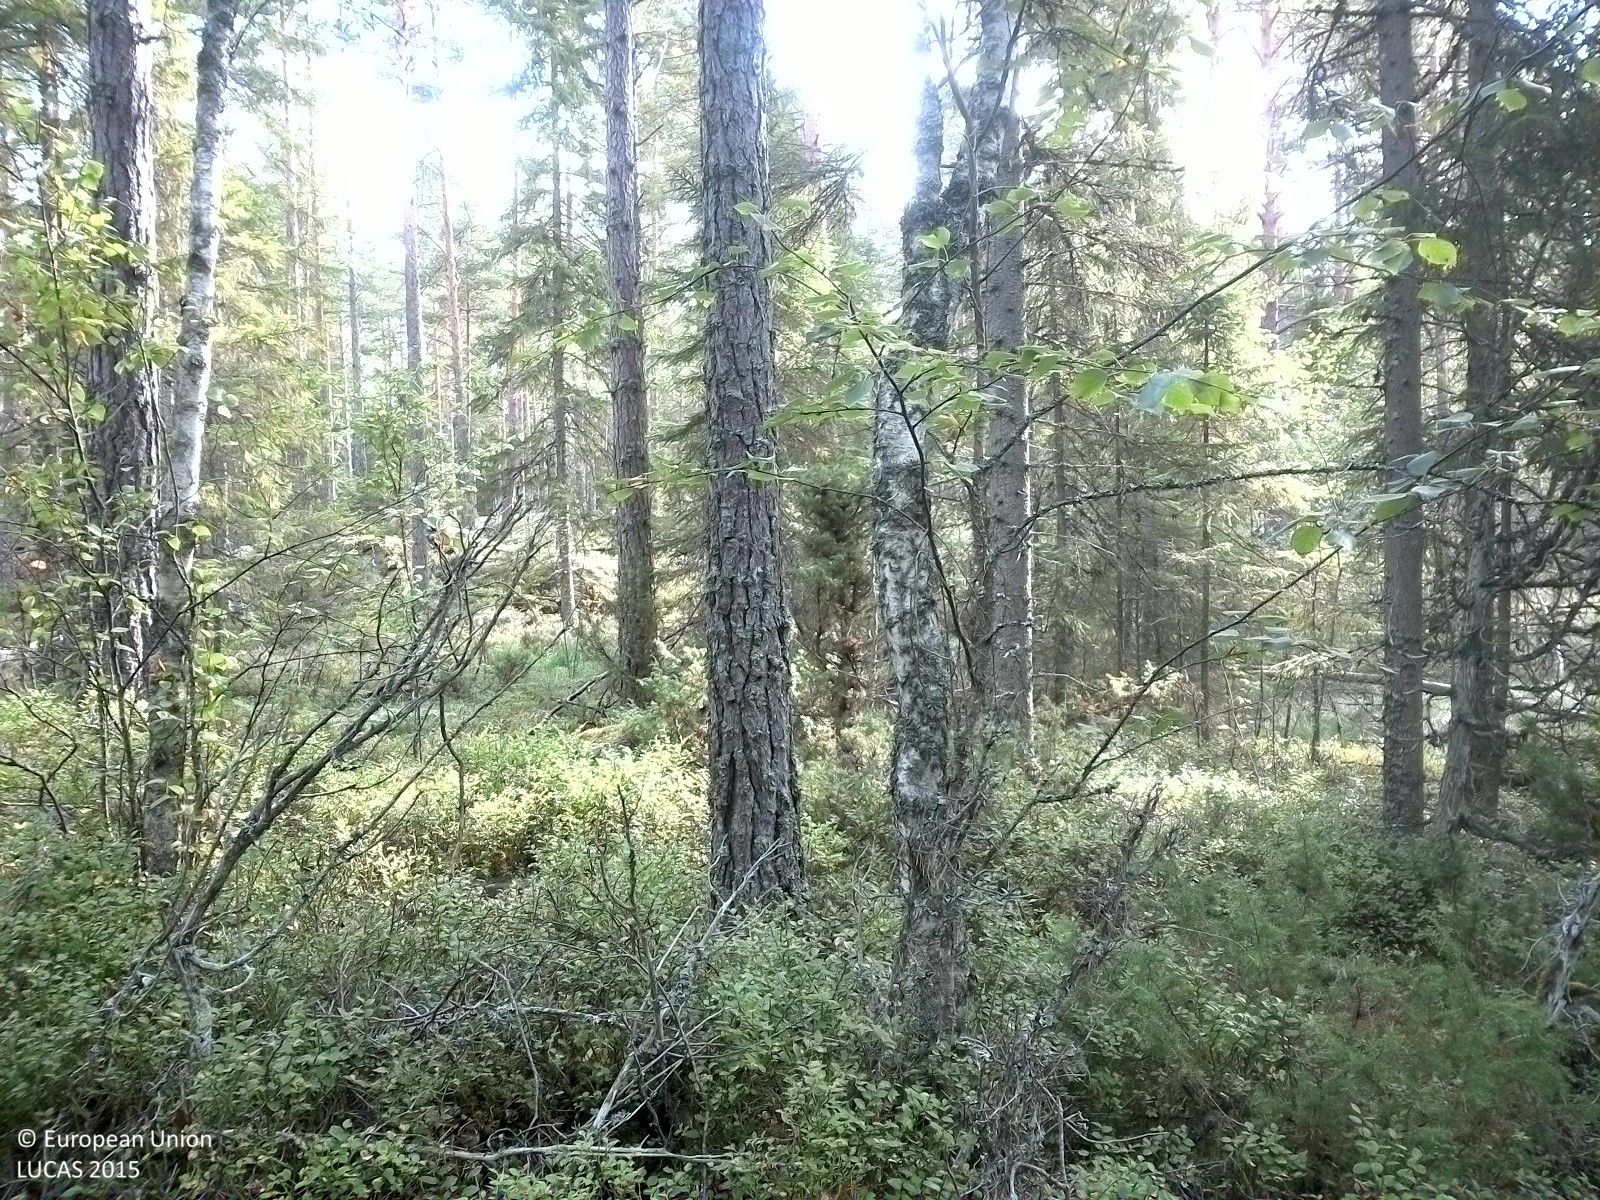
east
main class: Woodland
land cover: Pine dominated coniferous woodland
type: boreal forest
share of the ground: 25 - 50 %
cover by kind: coniferous forest trees 35 %, herbaceous plants 35 %, lichens and mosses 20 %, broadleaved forest trees 5 %, shrubs 5 %
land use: Forestry
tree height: > 5 m
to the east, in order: Pine dominated coniferous woodland; Spruce dominated coniferous woodland
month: August
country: SE
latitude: 58.8098
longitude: 15.5158
